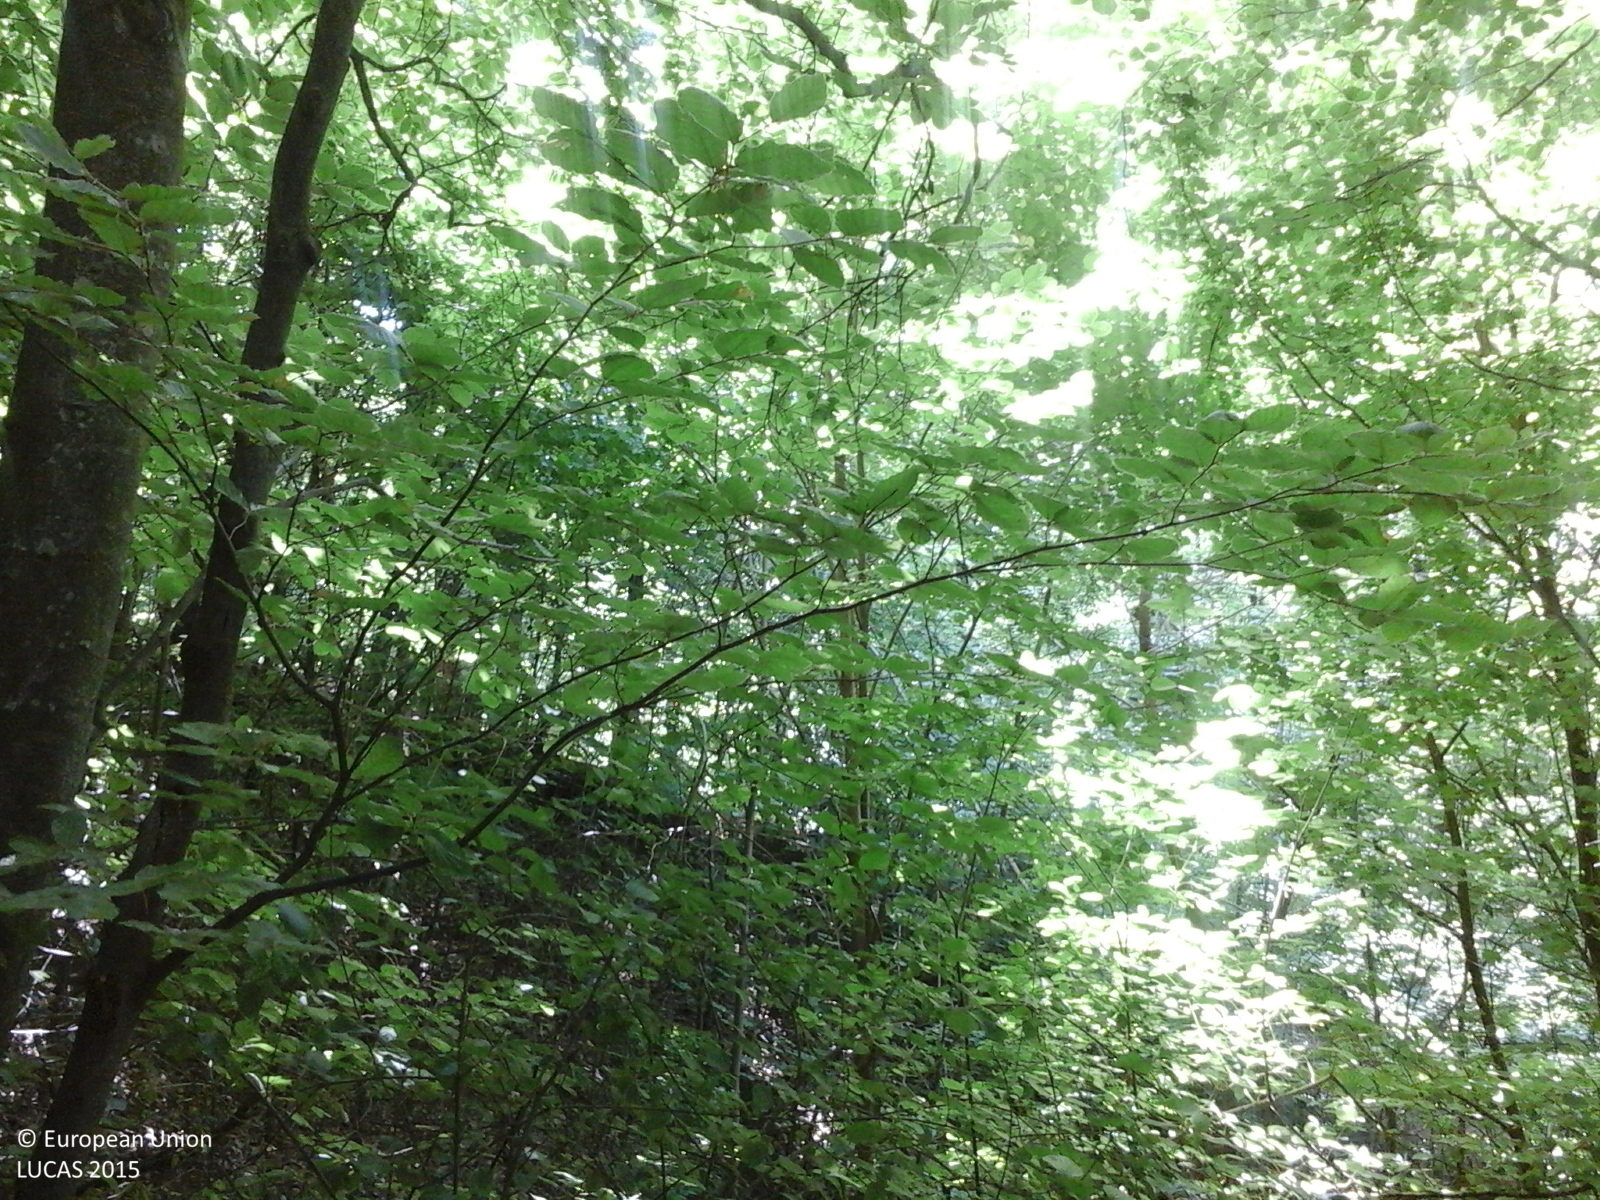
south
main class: Woodland
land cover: Broadleaved woodland
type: beech forest
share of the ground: > 75 %
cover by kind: broadleaved forest trees 100 %
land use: Forestry
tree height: > 5 m
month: June
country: RO
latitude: 46.6015
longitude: 26.7337
